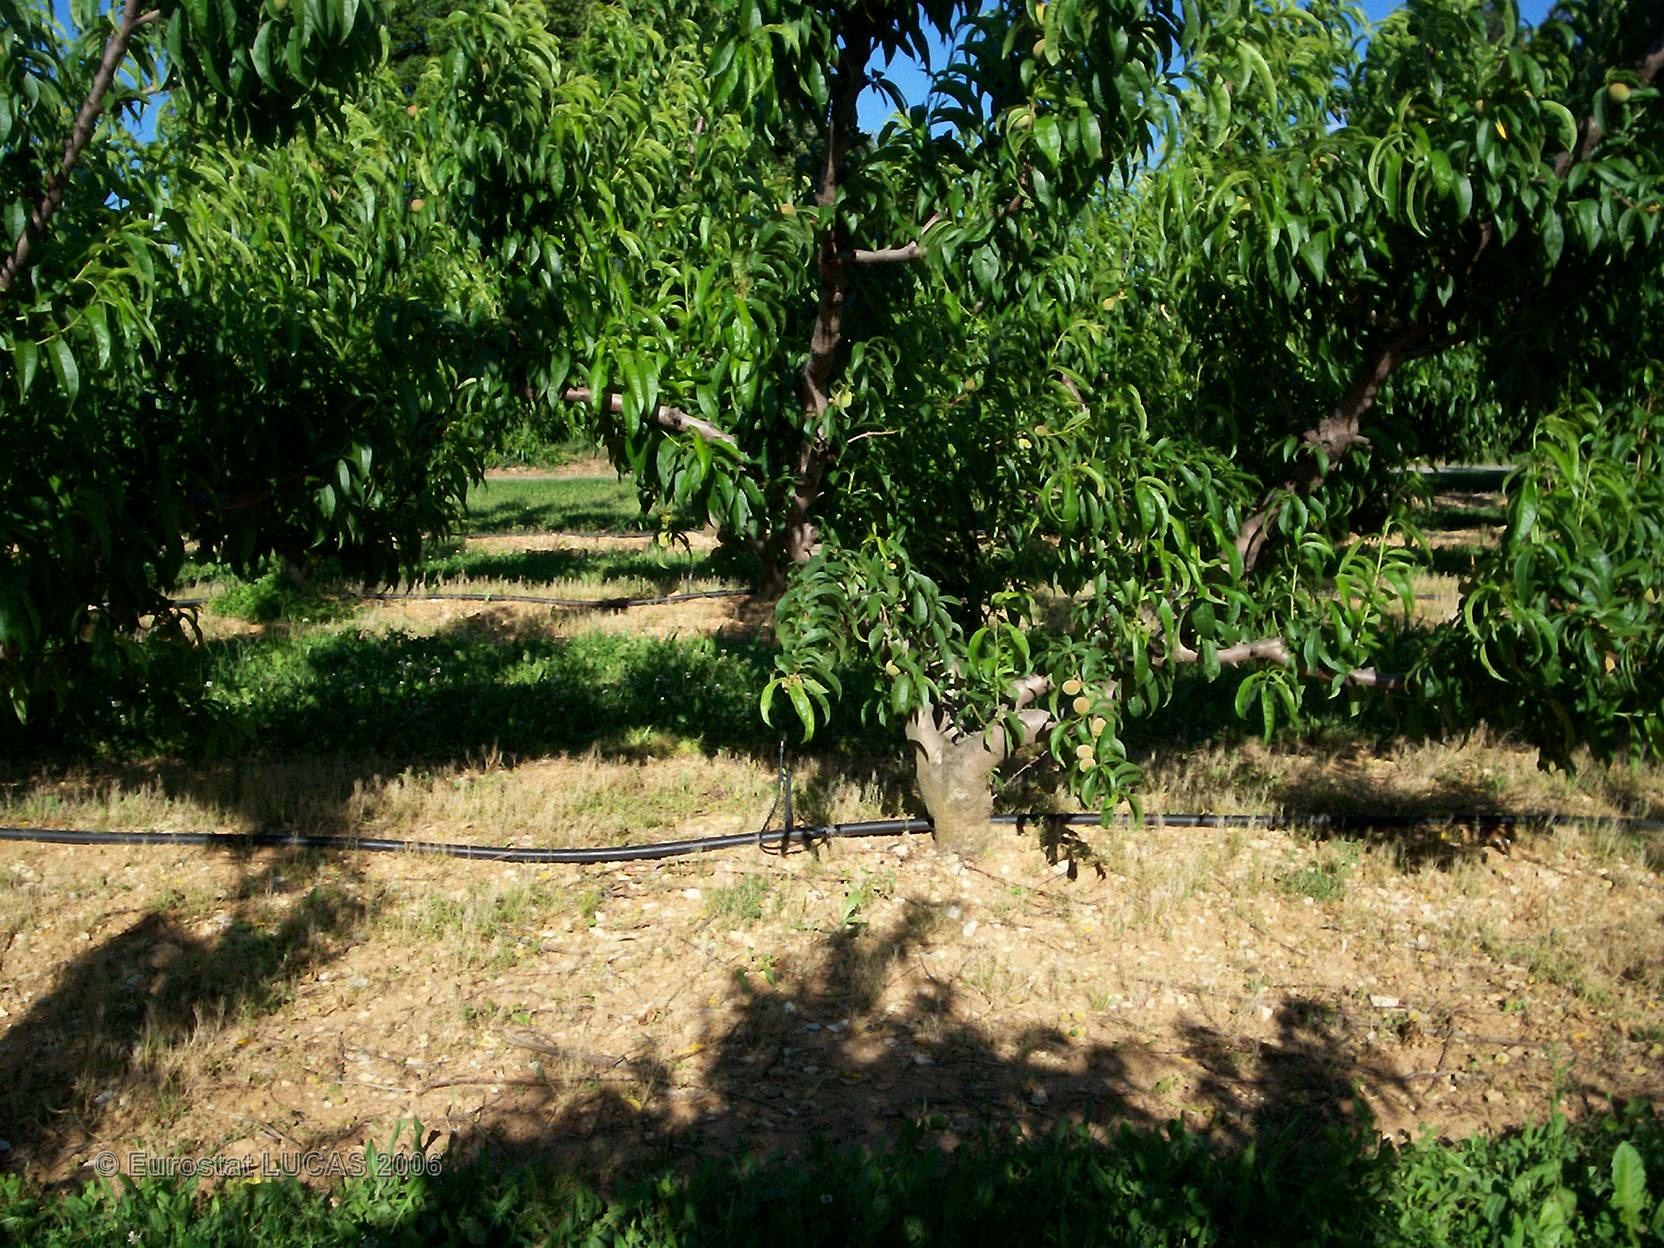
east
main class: Cropland
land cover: Other fruit trees and berries
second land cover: Grassland with sparse tree/shrub cover
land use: Agriculture (excluding fallow land and kitchen gardens)
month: May
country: FR
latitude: 44.6910
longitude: 4.8203
